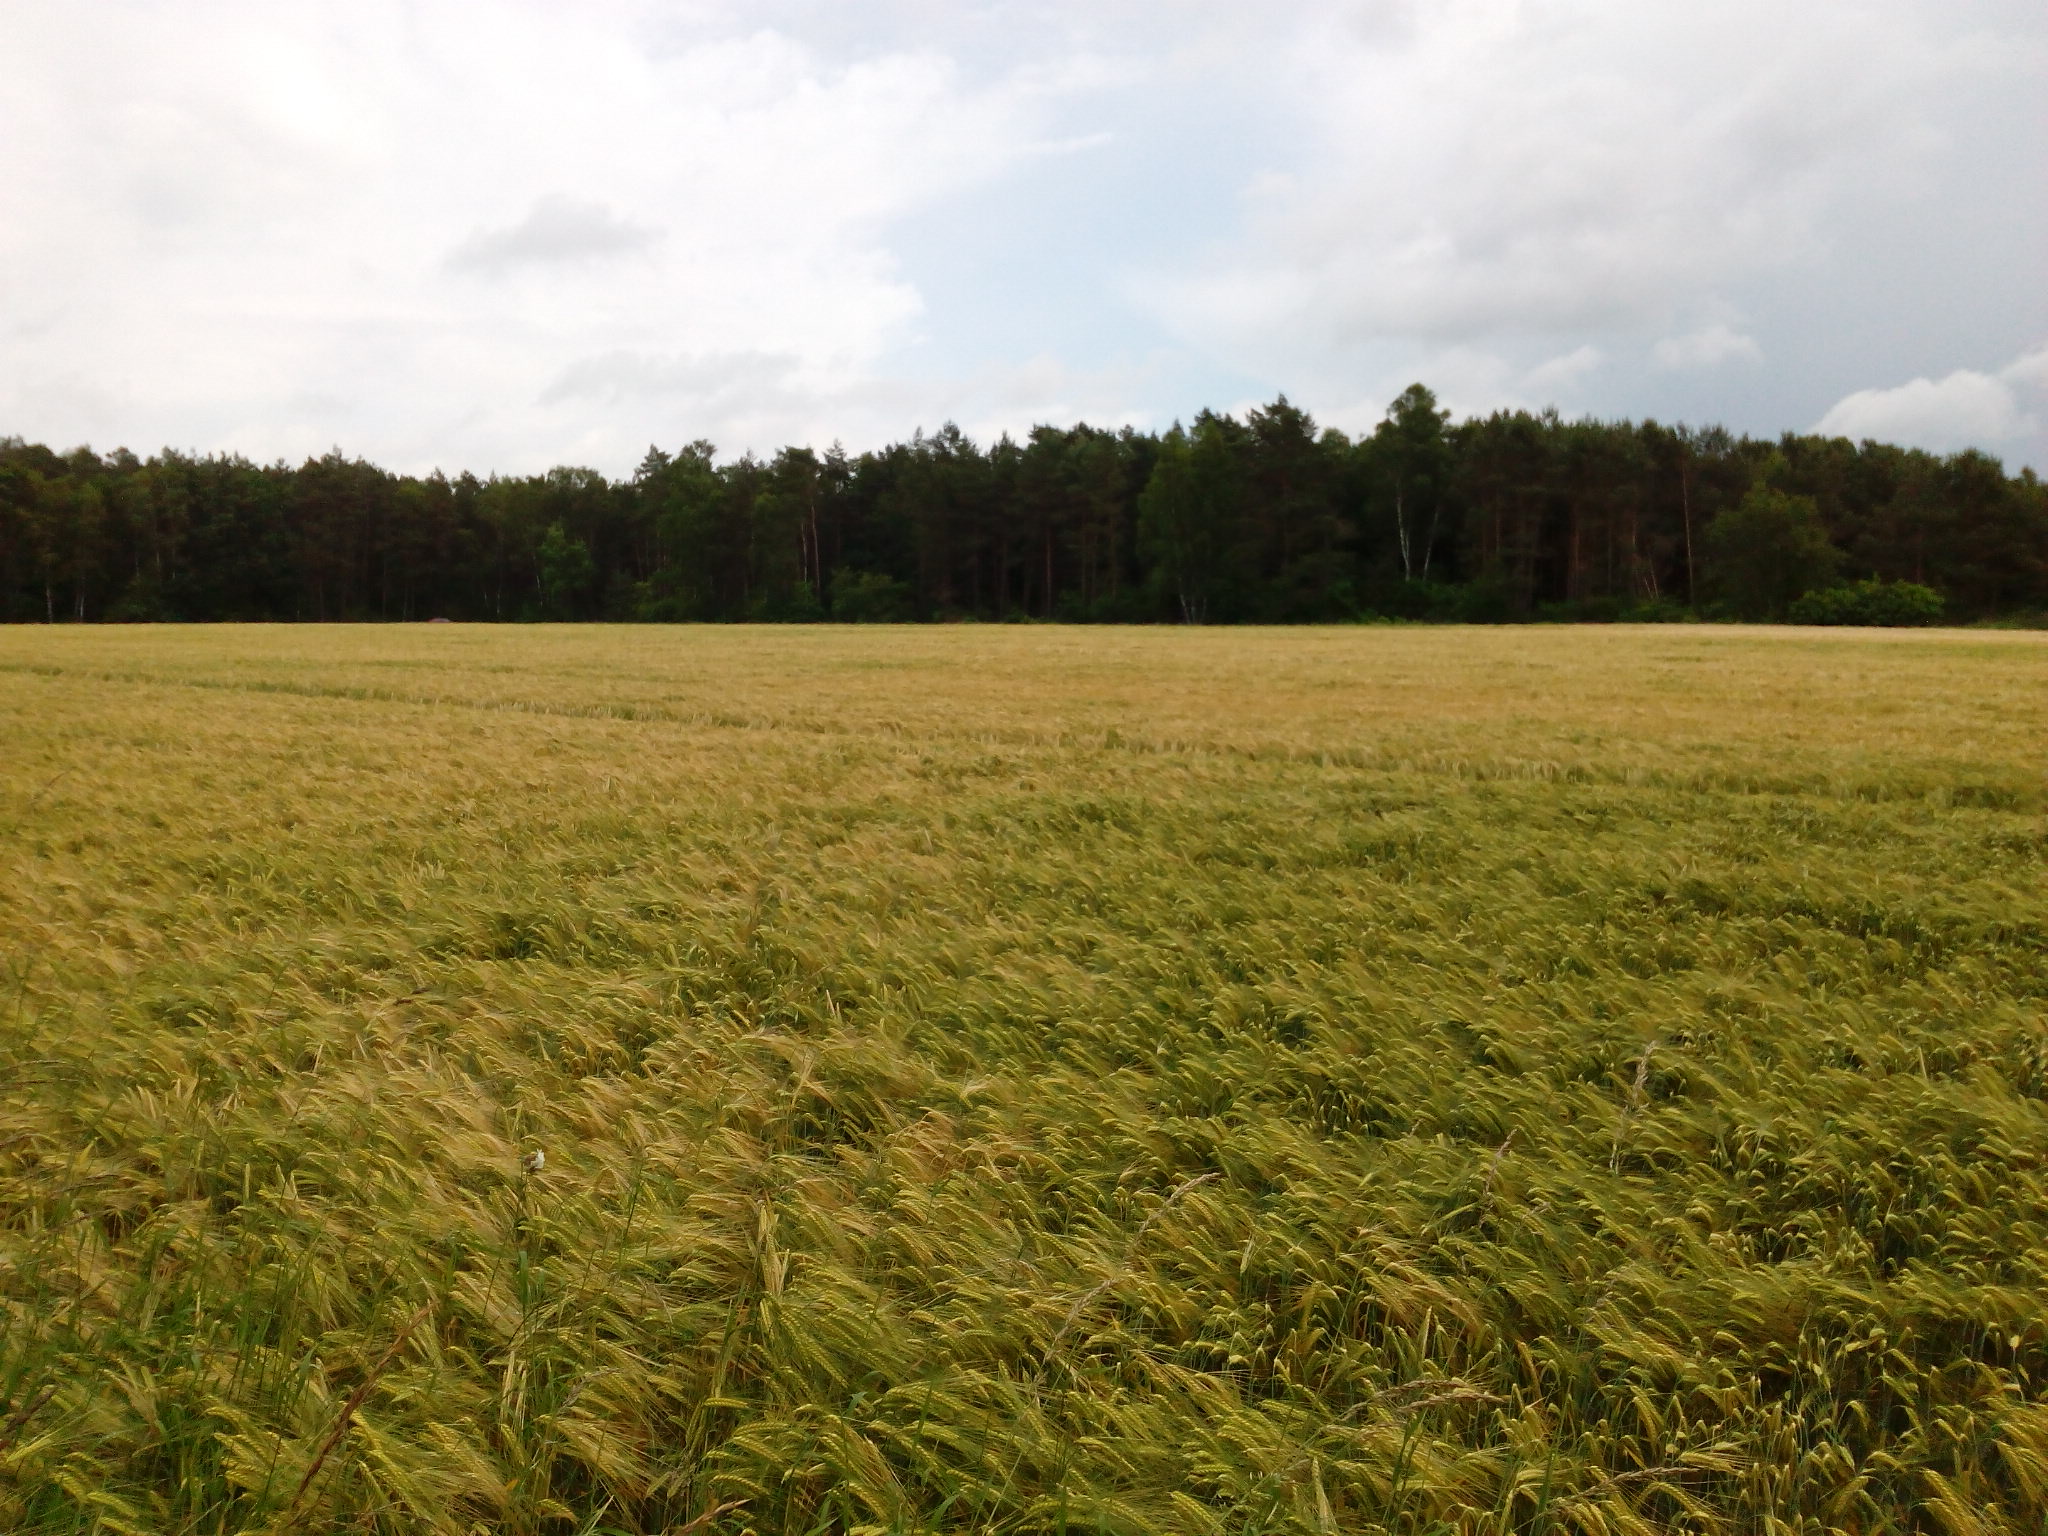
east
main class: Cropland
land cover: Barley
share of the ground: > 75 %
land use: Agriculture (excluding fallow land and kitchen gardens)
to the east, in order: Barley; Tracks; Grass margins; Pine dominated coniferous woodland; Pine dominated mixed woodland; Grassland without tree/shrub cover; Barley; Tracks; Grass margins; Pine dominated mixed woodland
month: June
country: DE
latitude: 52.7728
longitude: 9.9259
